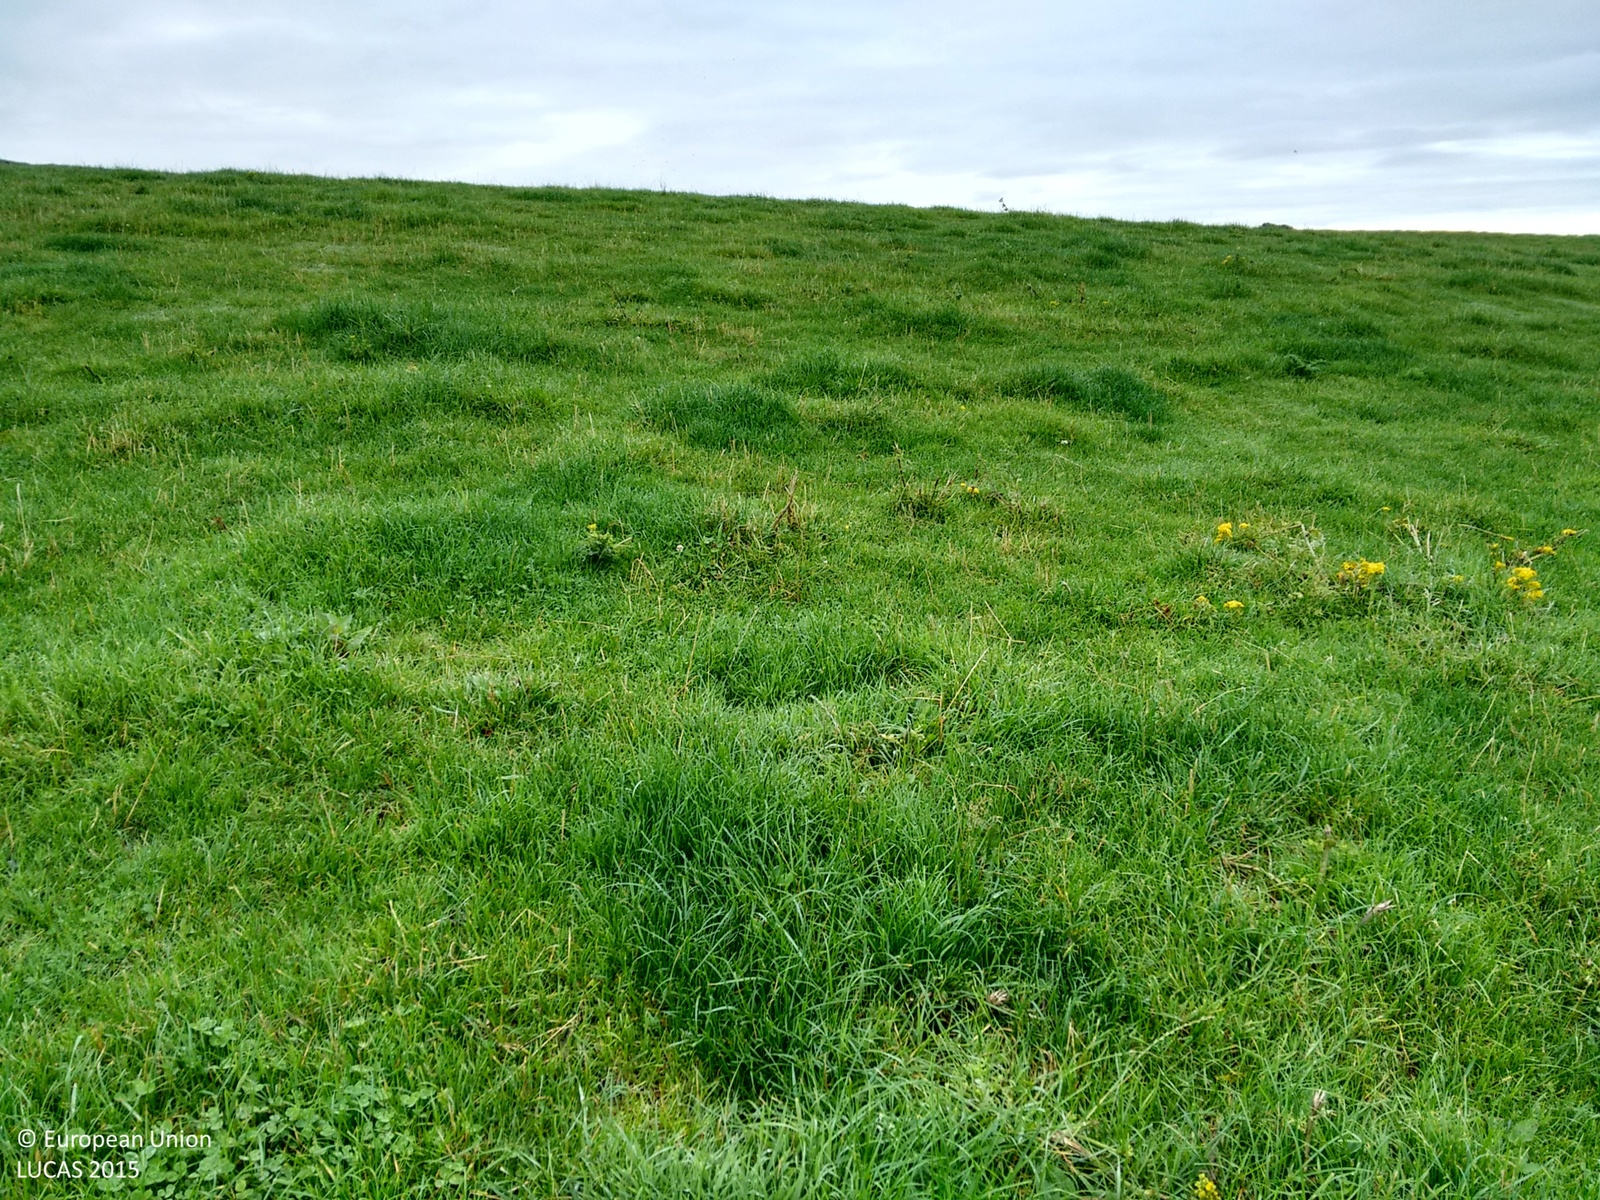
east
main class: Grassland
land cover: Grassland without tree/shrub cover
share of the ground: > 75 %
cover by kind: herbaceous plants 100 %
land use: Agriculture (excluding fallow land and kitchen gardens)
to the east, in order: Grassland without tree/shrub cover
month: August
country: GB
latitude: 54.8813
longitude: -4.9674
